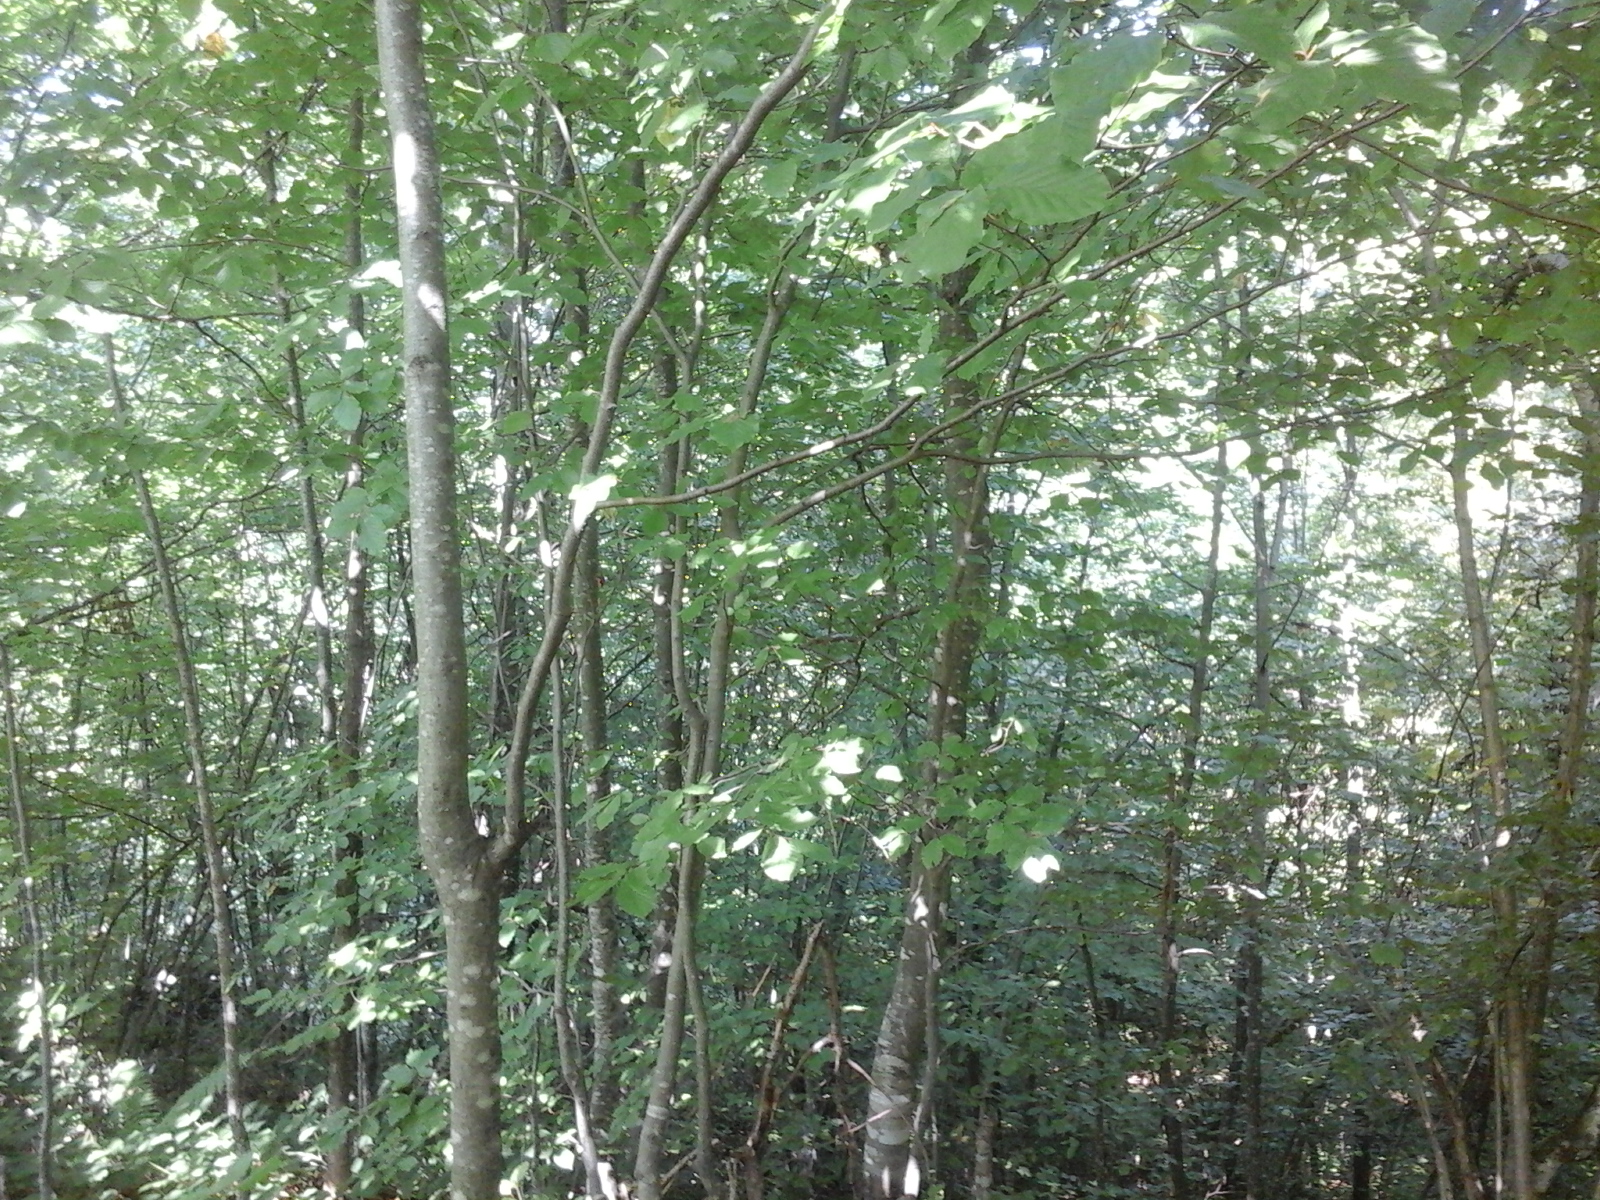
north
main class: Woodland
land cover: Broadleaved woodland
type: beech forest
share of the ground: > 75 %
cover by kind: broadleaved forest trees 100 %
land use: Forestry
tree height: > 5 m
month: September
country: RO
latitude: 46.5986
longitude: 22.6513
